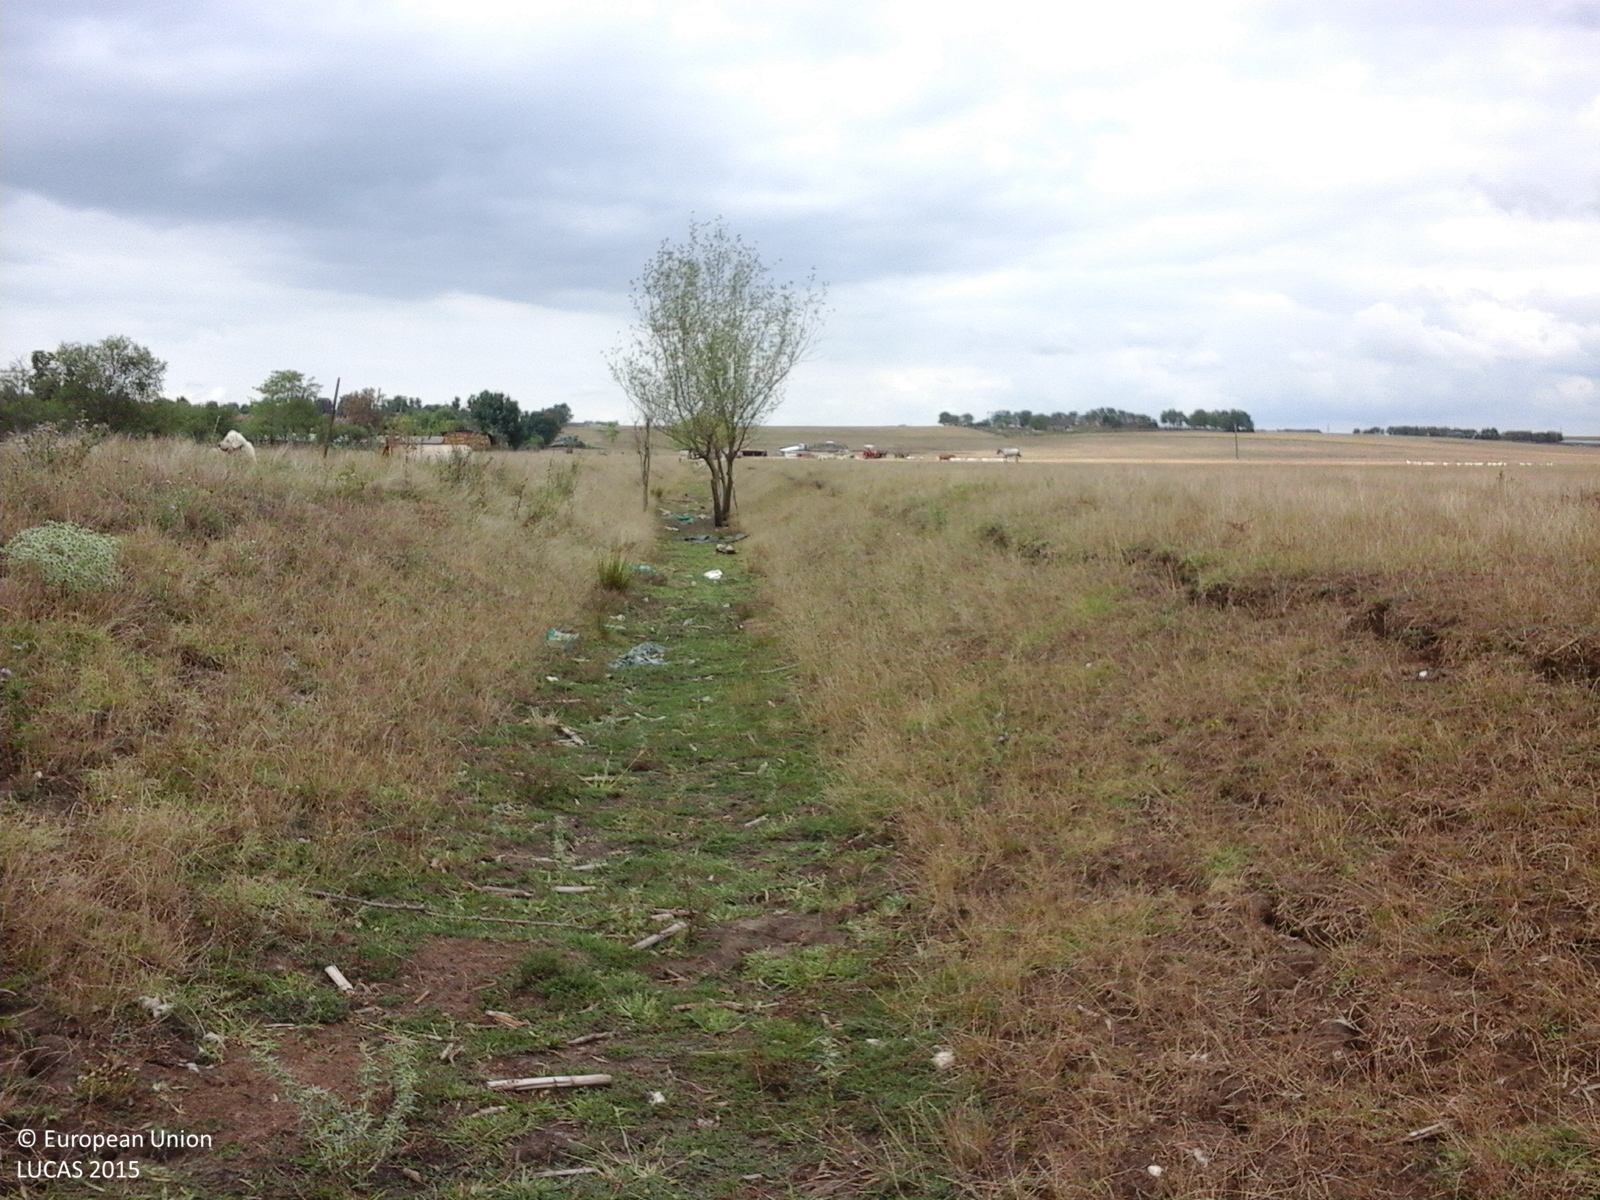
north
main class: Grassland
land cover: Grassland without tree/shrub cover
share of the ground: > 75 %
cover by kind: herbaceous plants 100 %
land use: Agriculture (excluding fallow land and kitchen gardens)
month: August
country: RO
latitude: 45.4528
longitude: 21.5278
